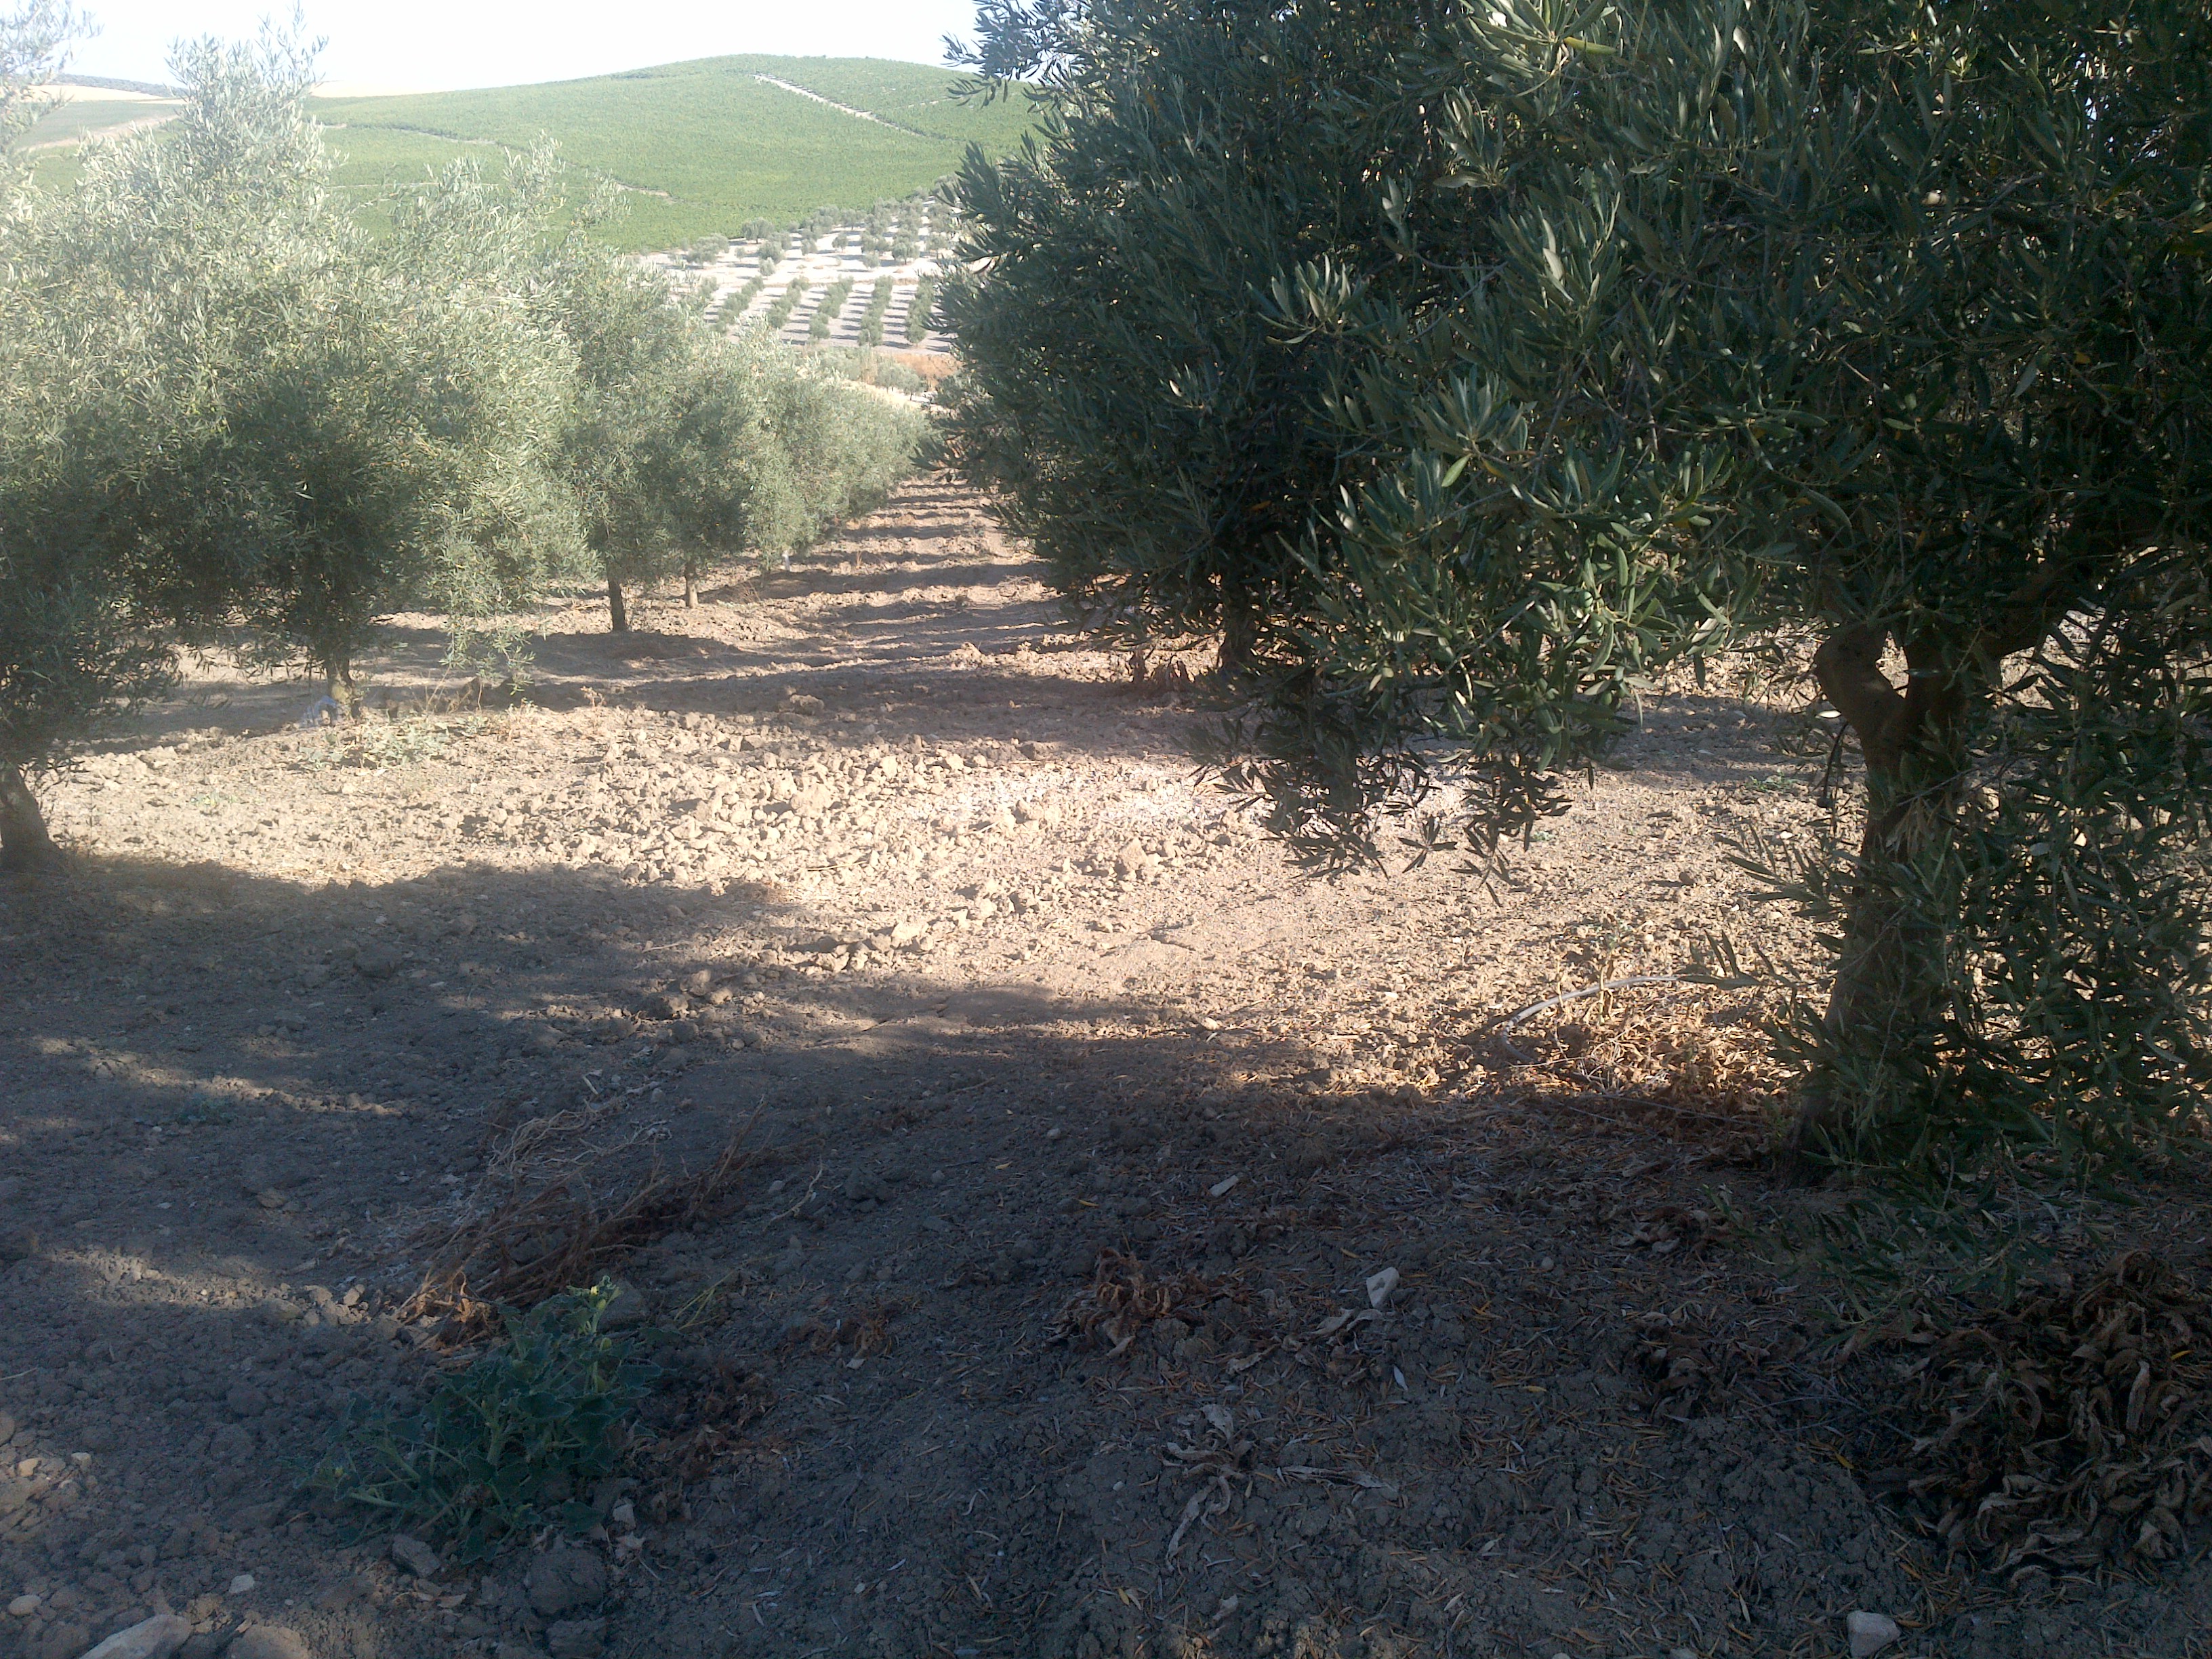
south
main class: Cropland
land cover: Olive groves
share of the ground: 50 - 75 %
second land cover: Other bare soil
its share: > 75 %
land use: Agriculture (excluding fallow land and kitchen gardens)
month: June
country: ES
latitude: 37.5498
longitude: -4.8489
